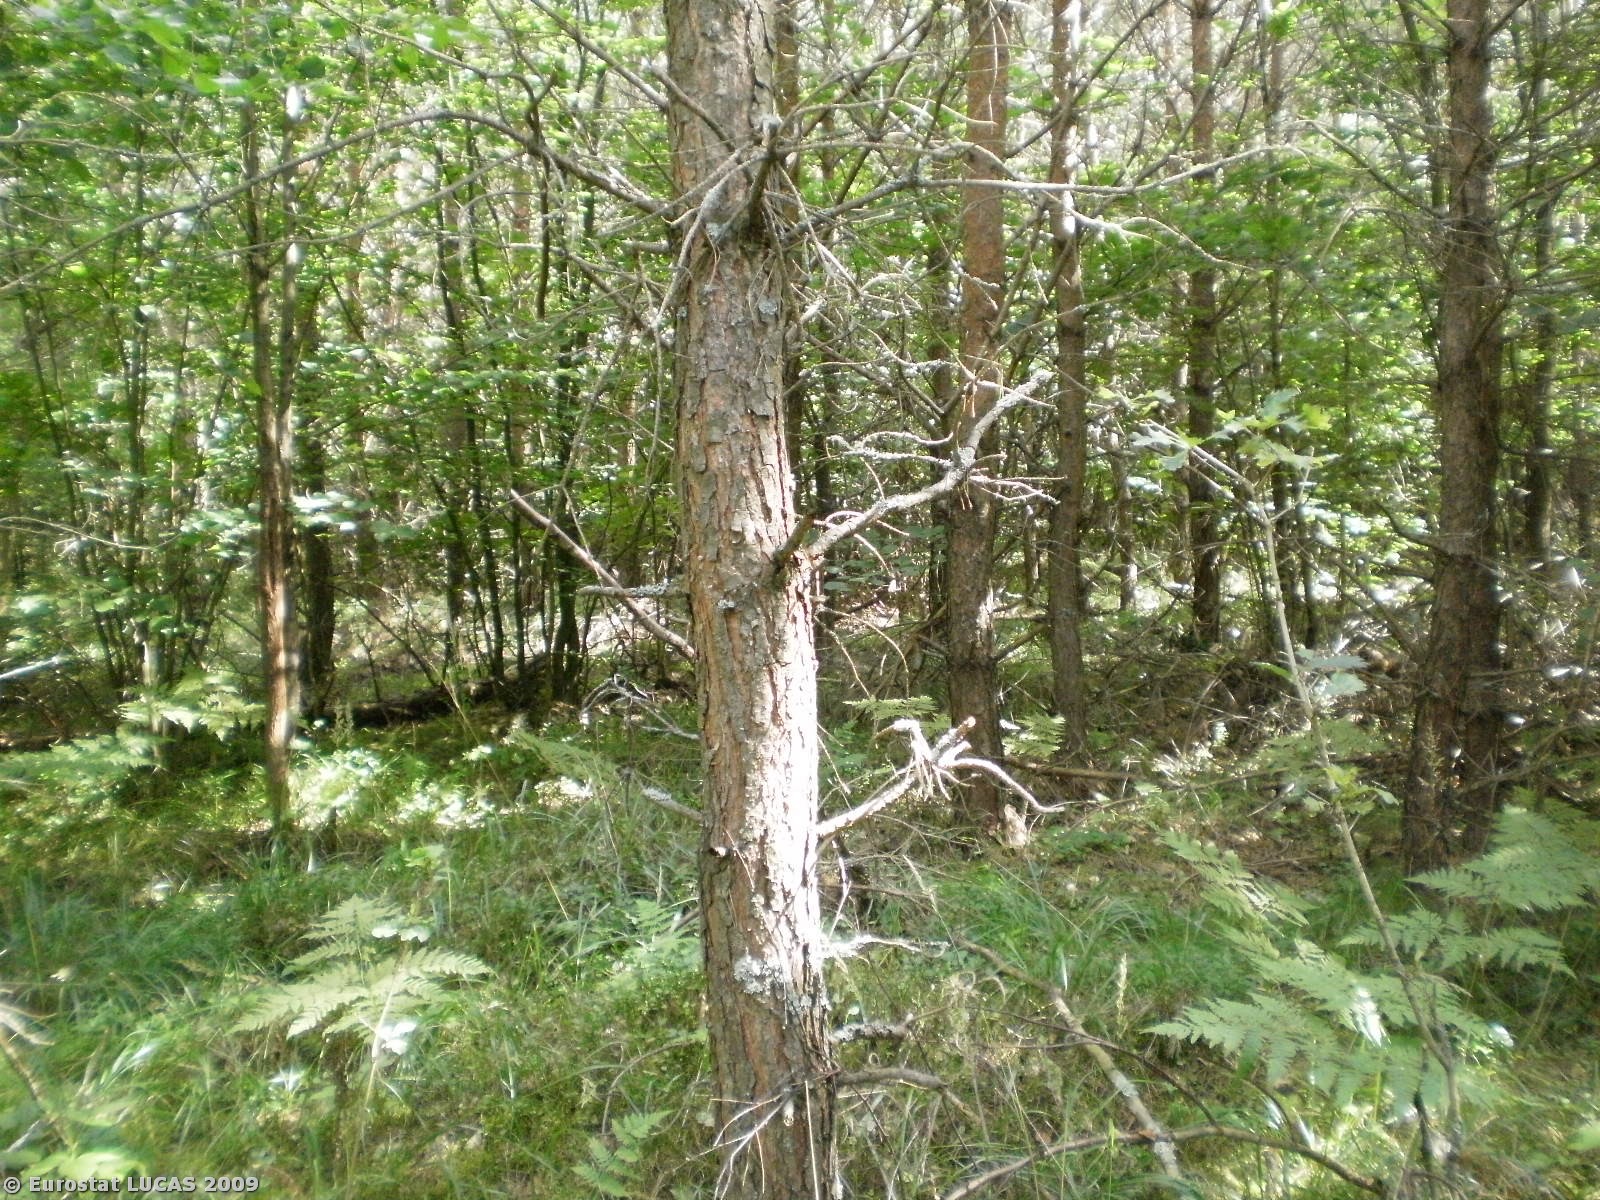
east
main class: Woodland
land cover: Mixed woodland
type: hemiboreal forest and nemoral coniferous forest and mixed broadleaved-coniferous forest
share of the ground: > 75 %
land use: Forestry
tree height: > 5 m
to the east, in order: Mixed woodland
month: July
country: PL
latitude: 53.4136
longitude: 20.5239
